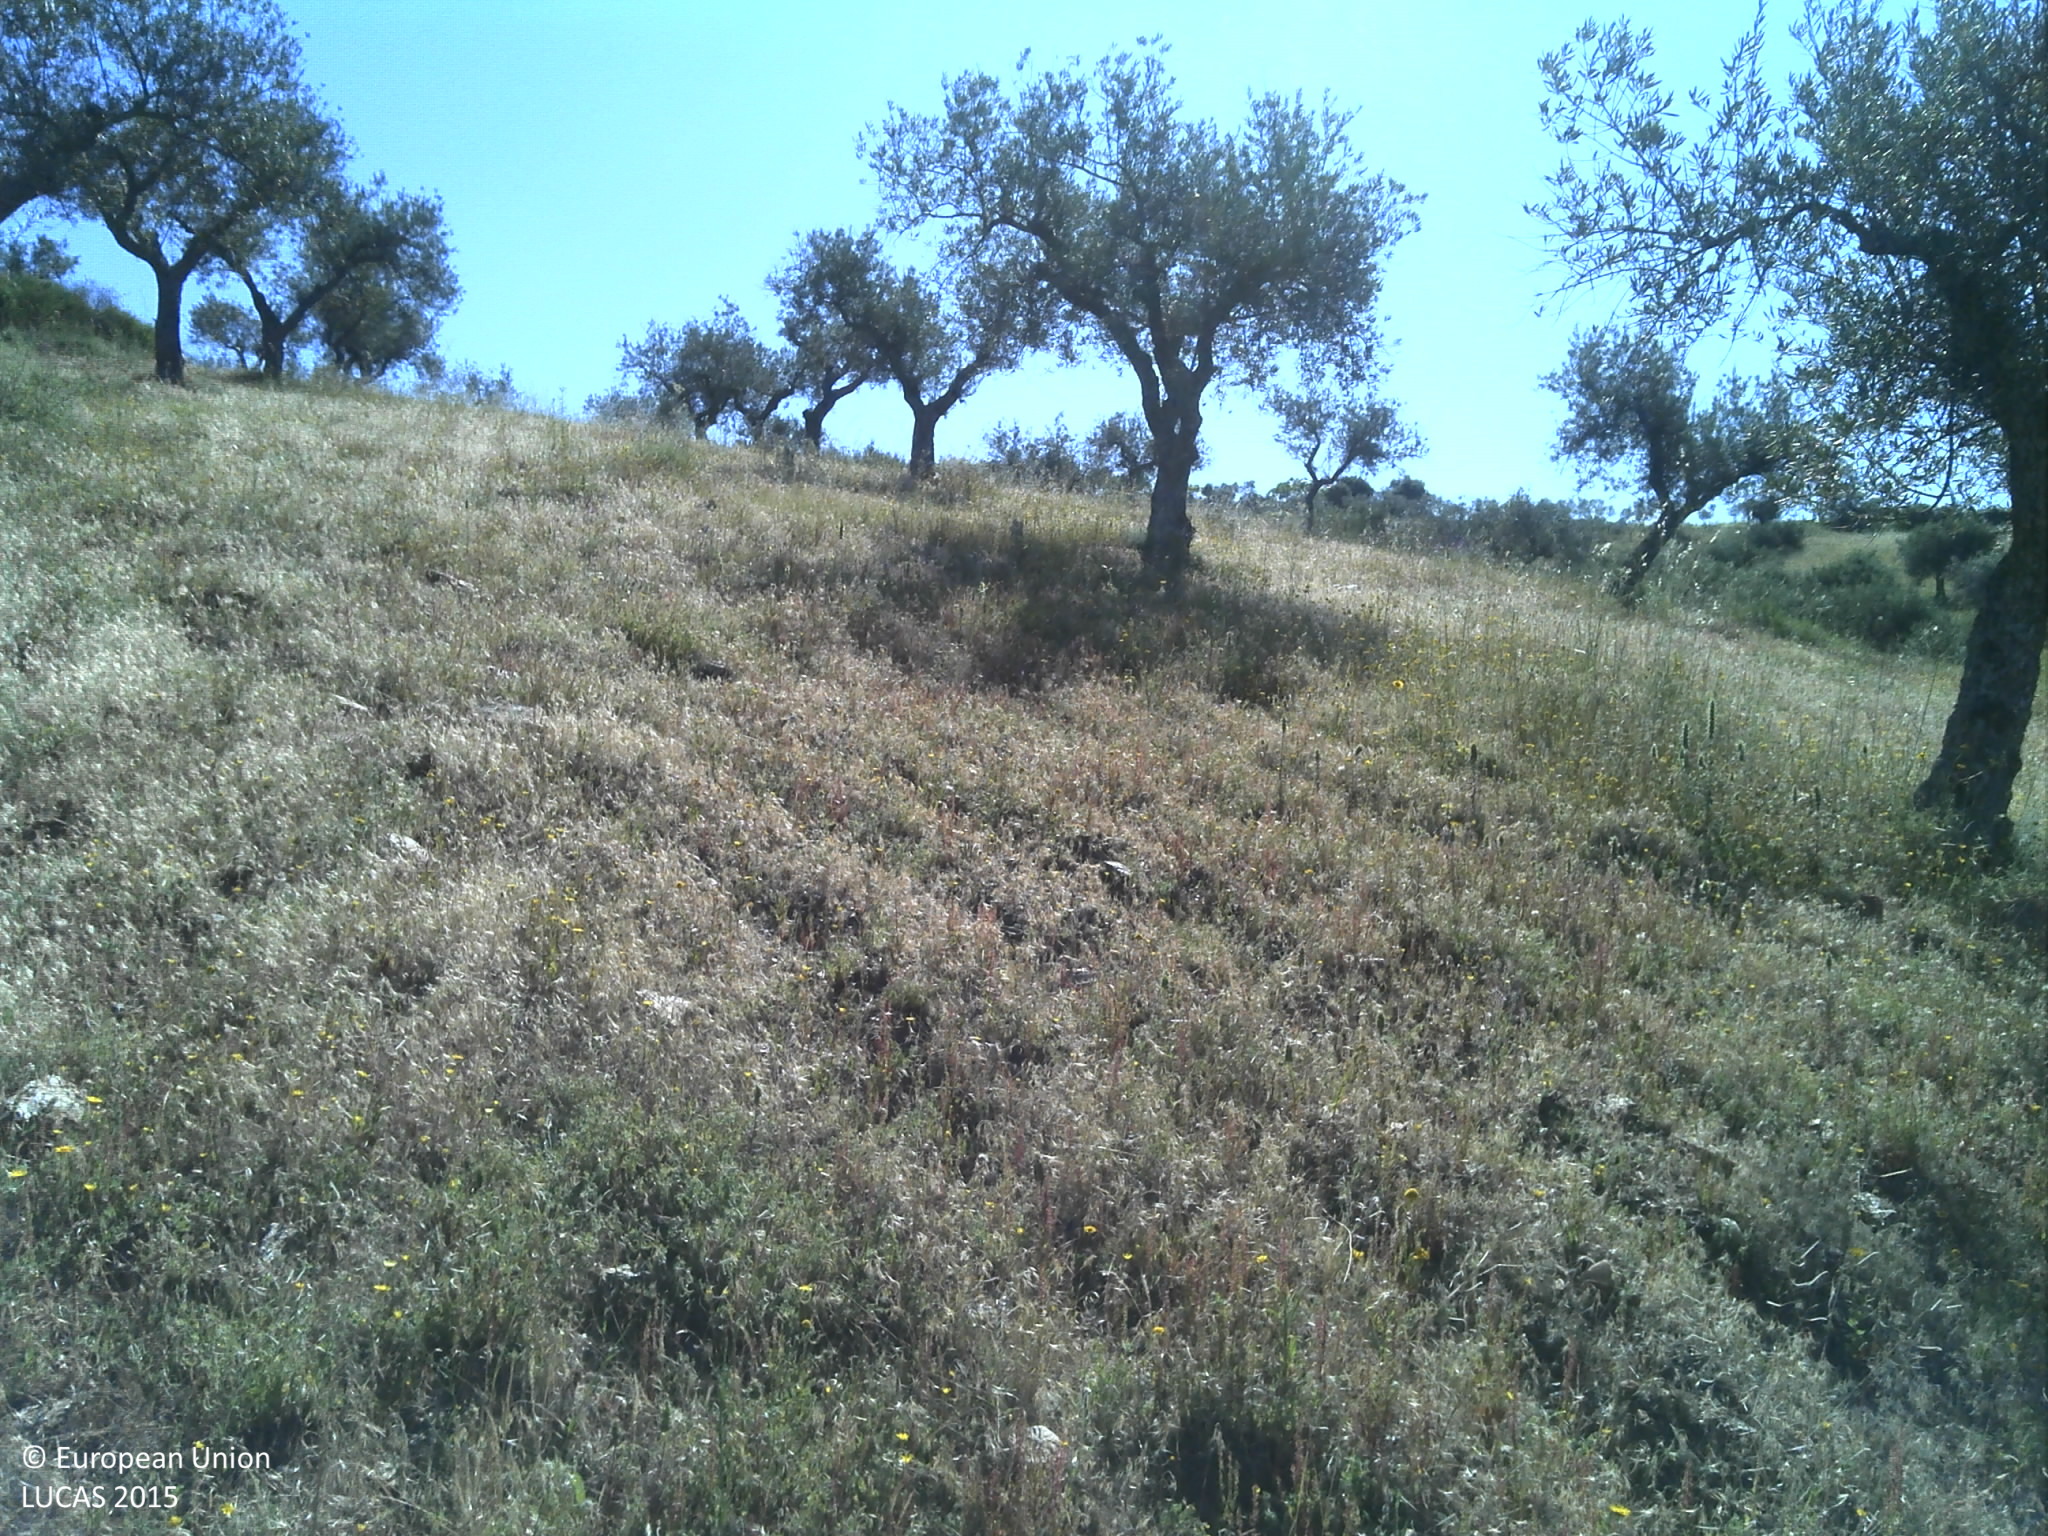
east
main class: Cropland
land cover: Olive groves
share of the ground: 25 - 50 %
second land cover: Grassland without tree/shrub cover
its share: 50 - 75 %
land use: Agriculture (excluding fallow land and kitchen gardens)
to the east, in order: Olive groves; Grassland without tree/shrub cover; Olive groves; Other fruit trees and berries; Olive groves; Other fruit trees and berries; Olive groves
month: May
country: PT
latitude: 41.5678
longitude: -7.1356
